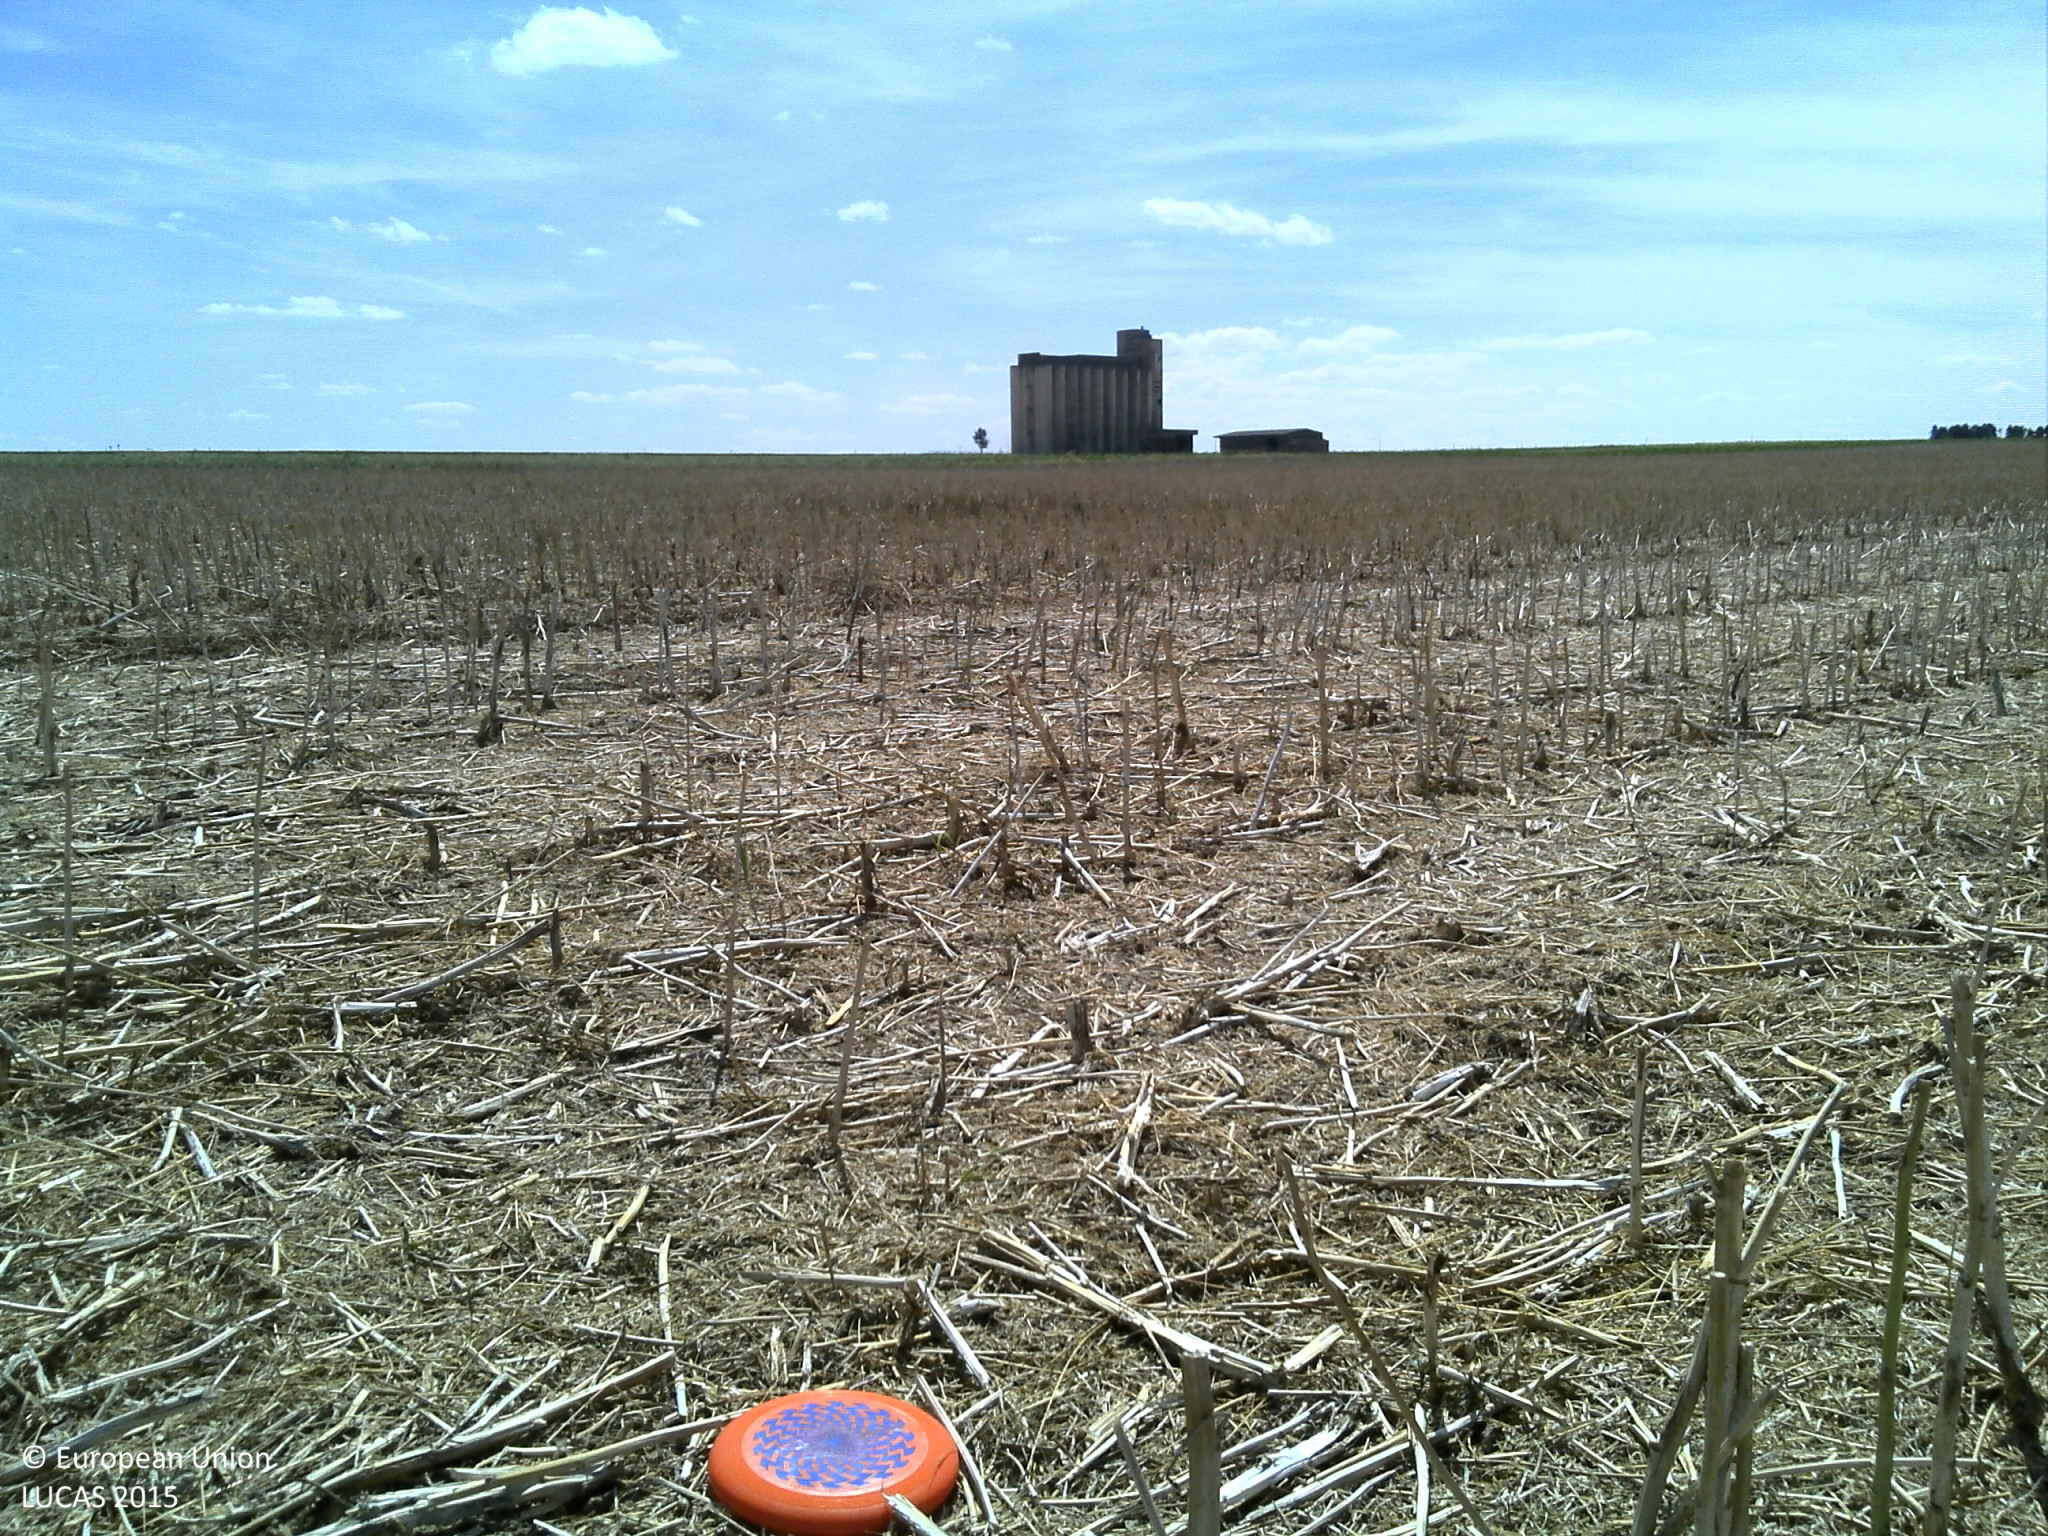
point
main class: Cropland
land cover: Rape and turnip rape
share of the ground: > 75 %
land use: Agriculture (excluding fallow land and kitchen gardens)
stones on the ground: < 10 %
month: August
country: FR
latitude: 48.9967
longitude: 4.6803
